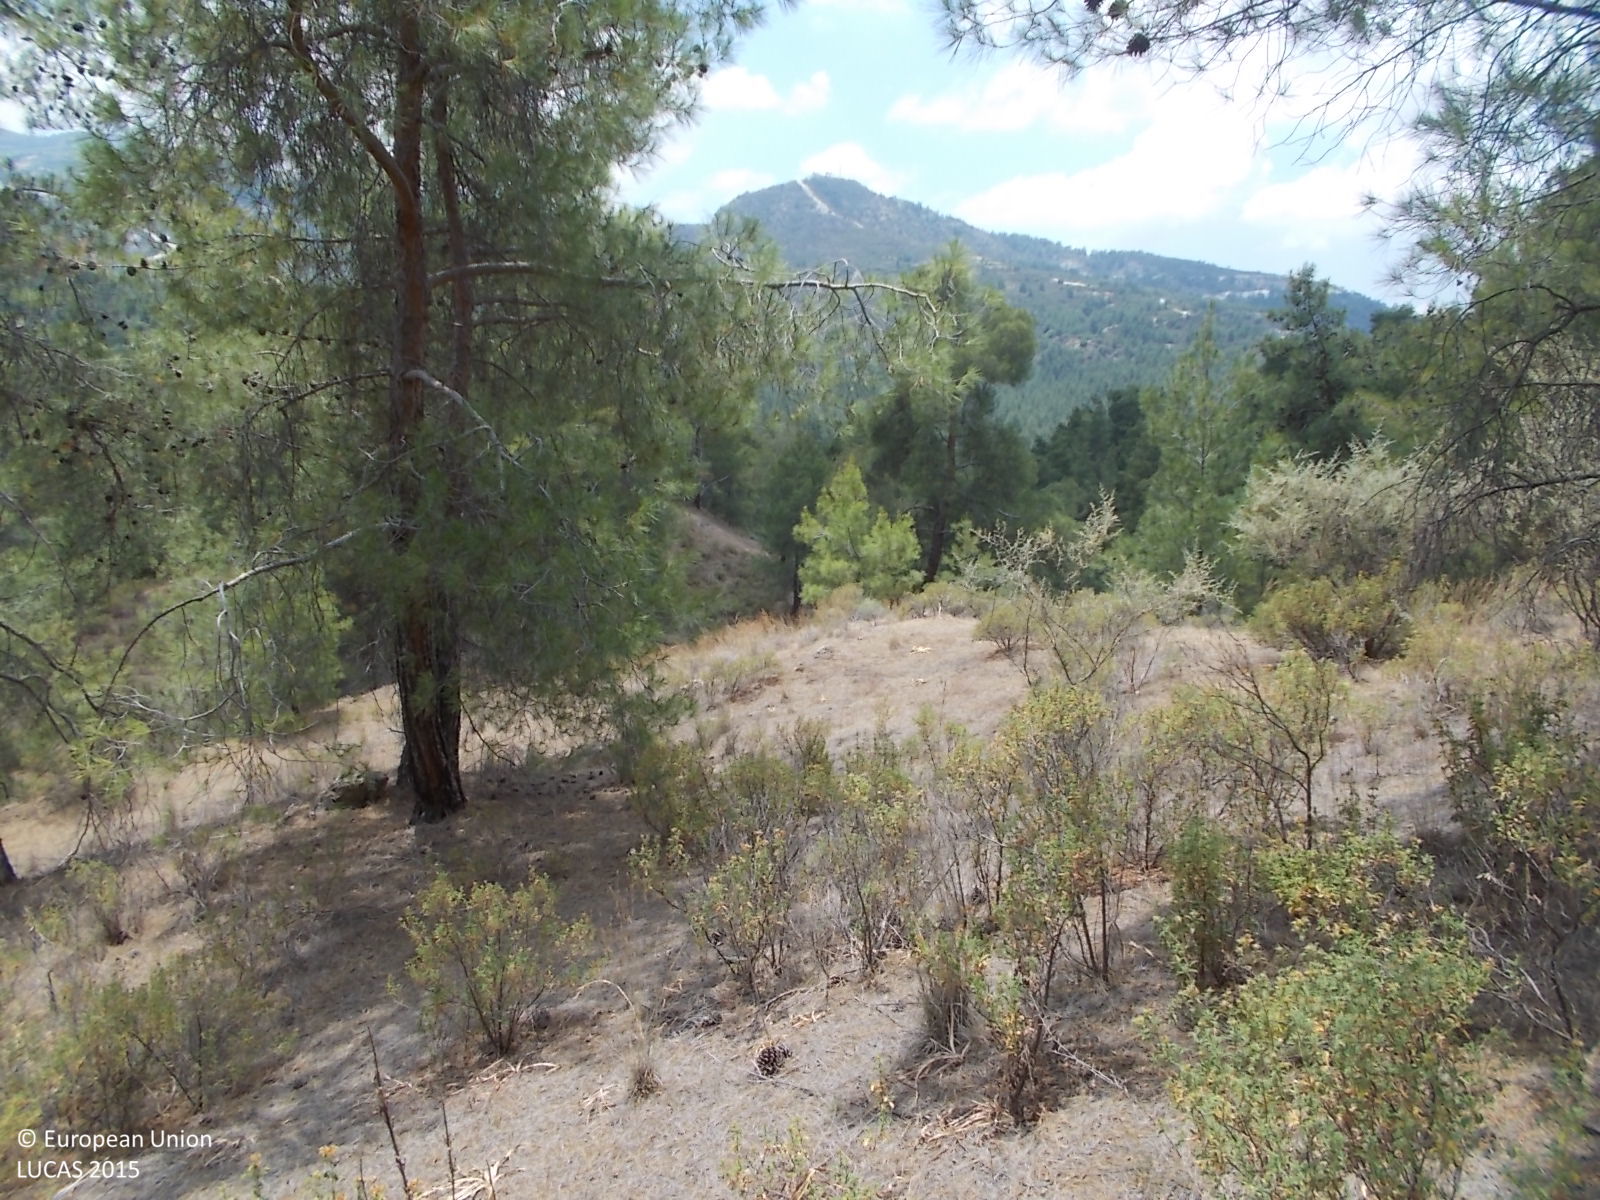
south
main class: Woodland
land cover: Pine dominated coniferous woodland
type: coniferous forest of the mediterranean region
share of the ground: 50 - 75 %
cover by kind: coniferous forest trees 70 %, unconsolidated bare surface 20 %, shrubs 10 %
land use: Forestry
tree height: > 5 m
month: June
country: CY
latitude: 34.8932
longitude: 32.7574
